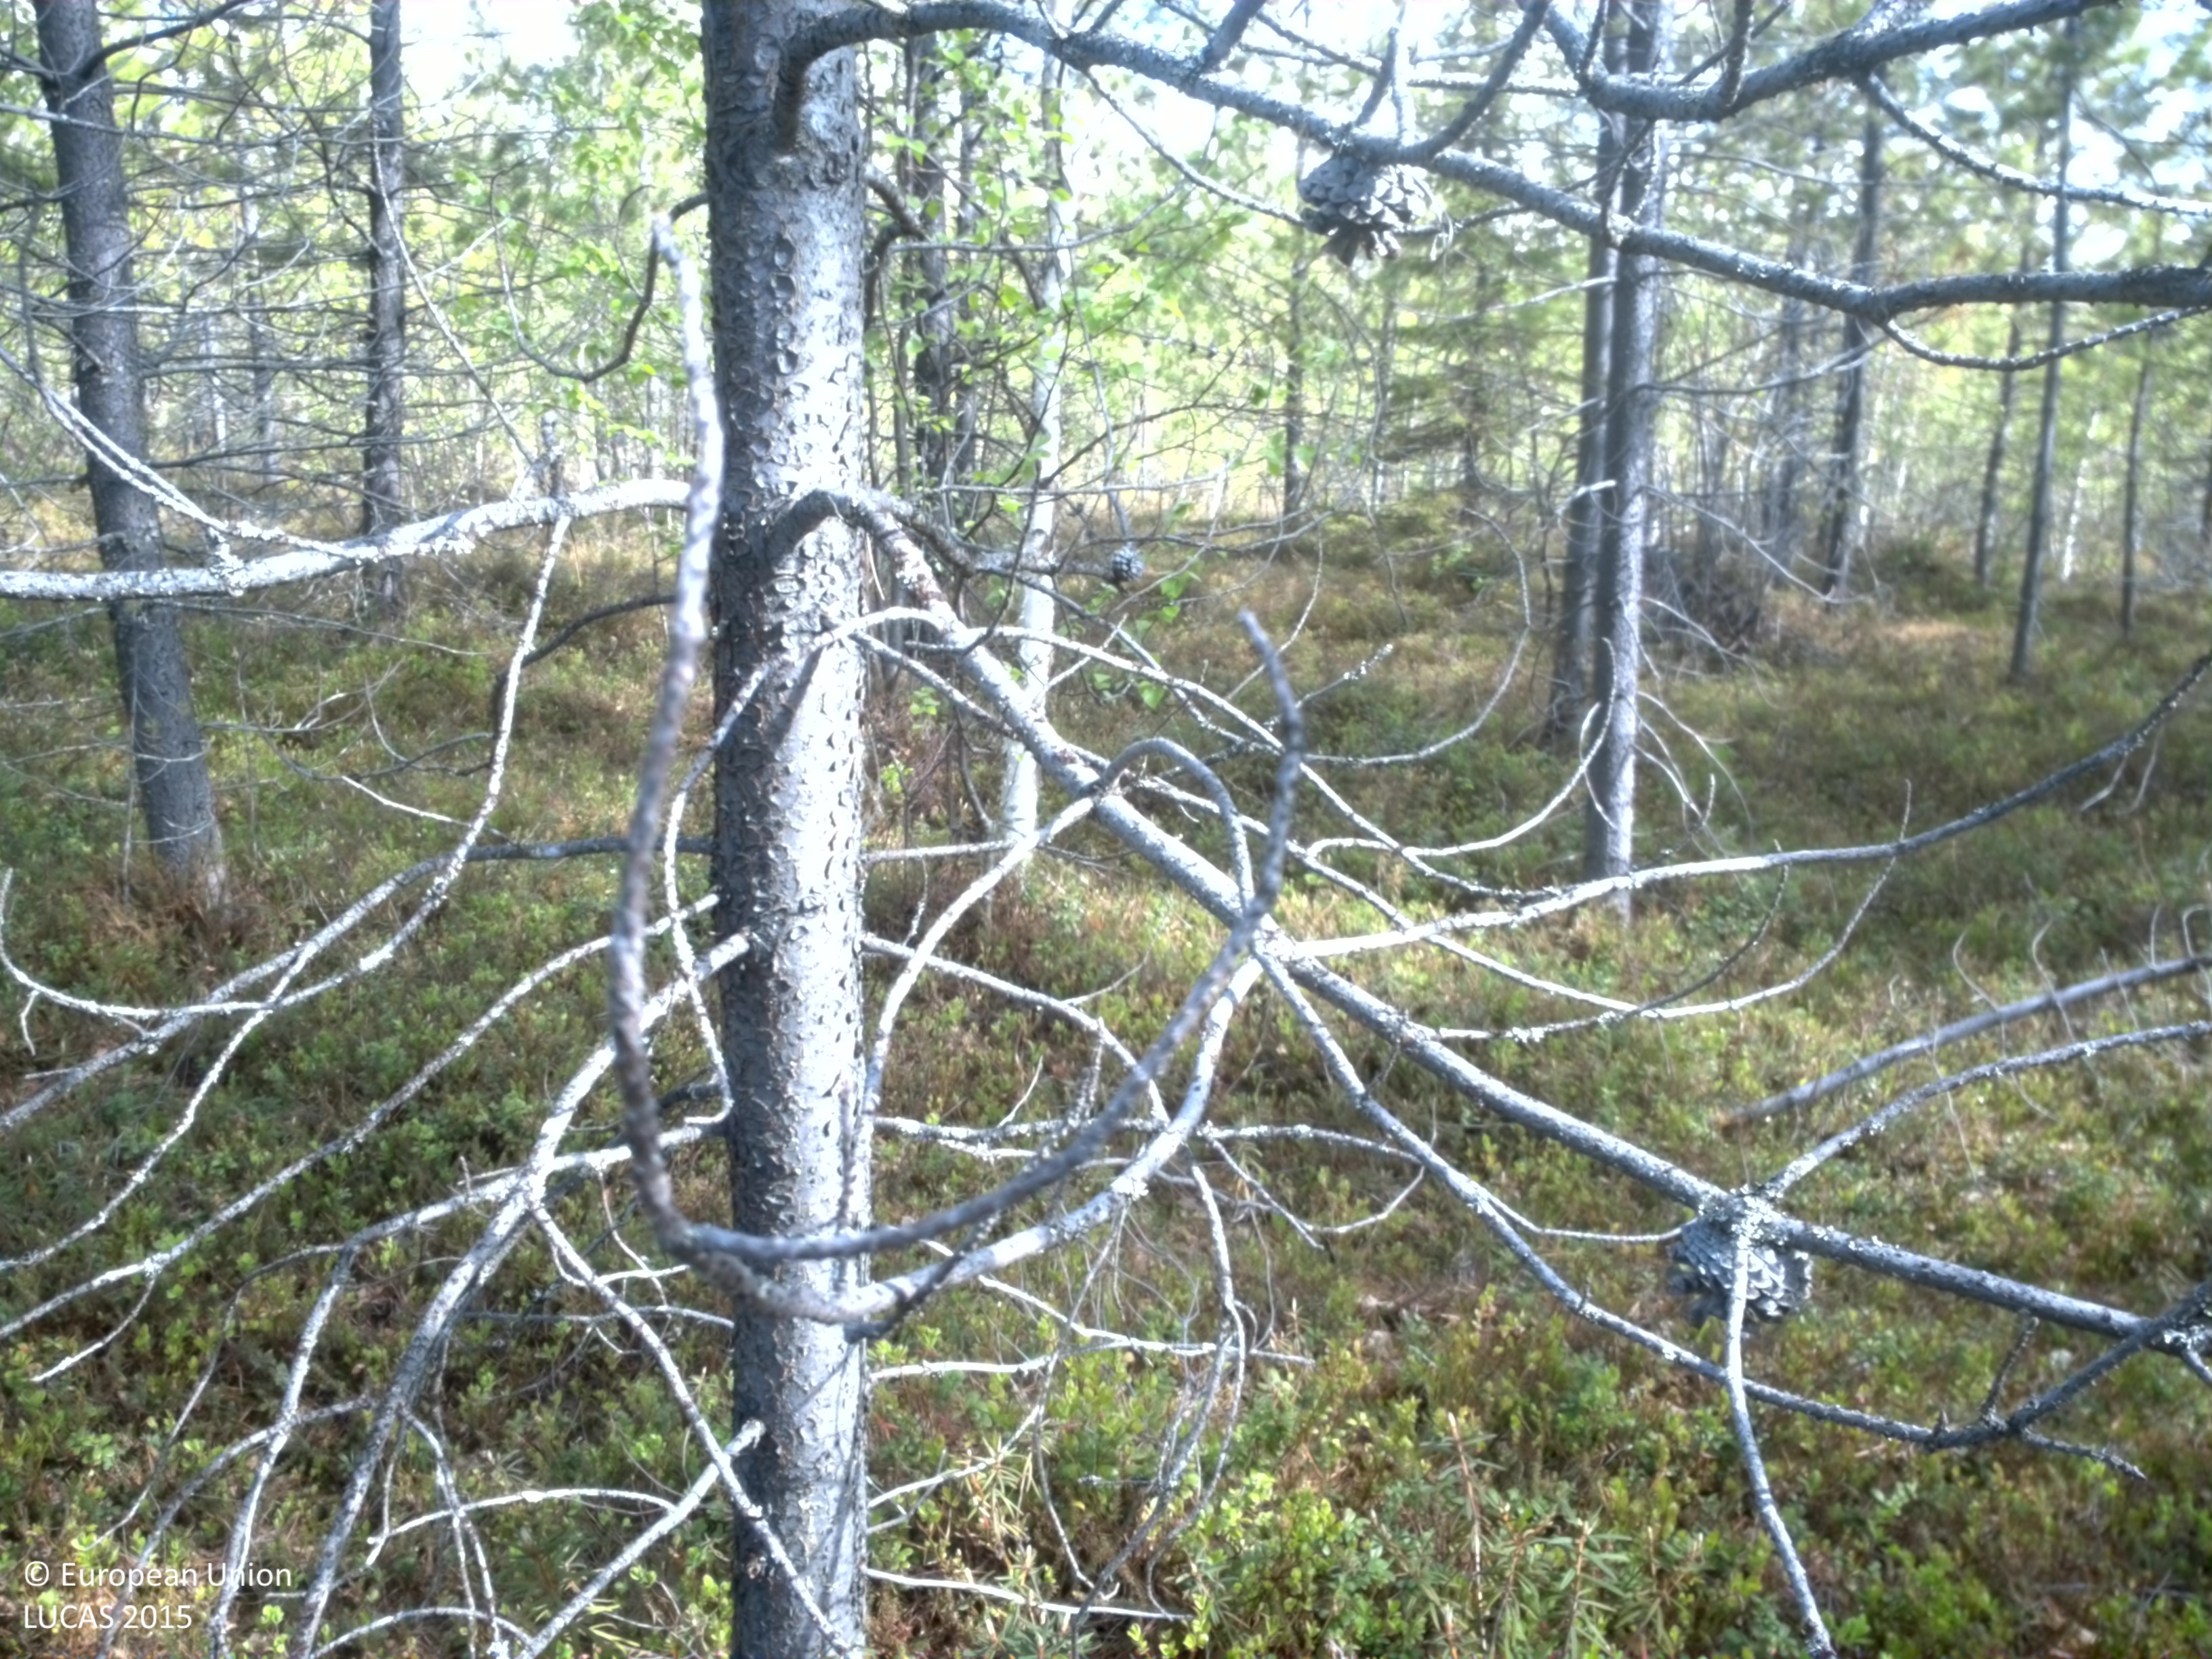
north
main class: Woodland
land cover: Pine dominated mixed woodland
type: boreal forest
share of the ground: 25 - 50 %
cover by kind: shrubs 60 %, coniferous forest trees 25 %, broadleaved forest trees 15 %
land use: Forestry
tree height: > 5 m
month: June
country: SE
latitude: 67.0041
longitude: 21.7253
